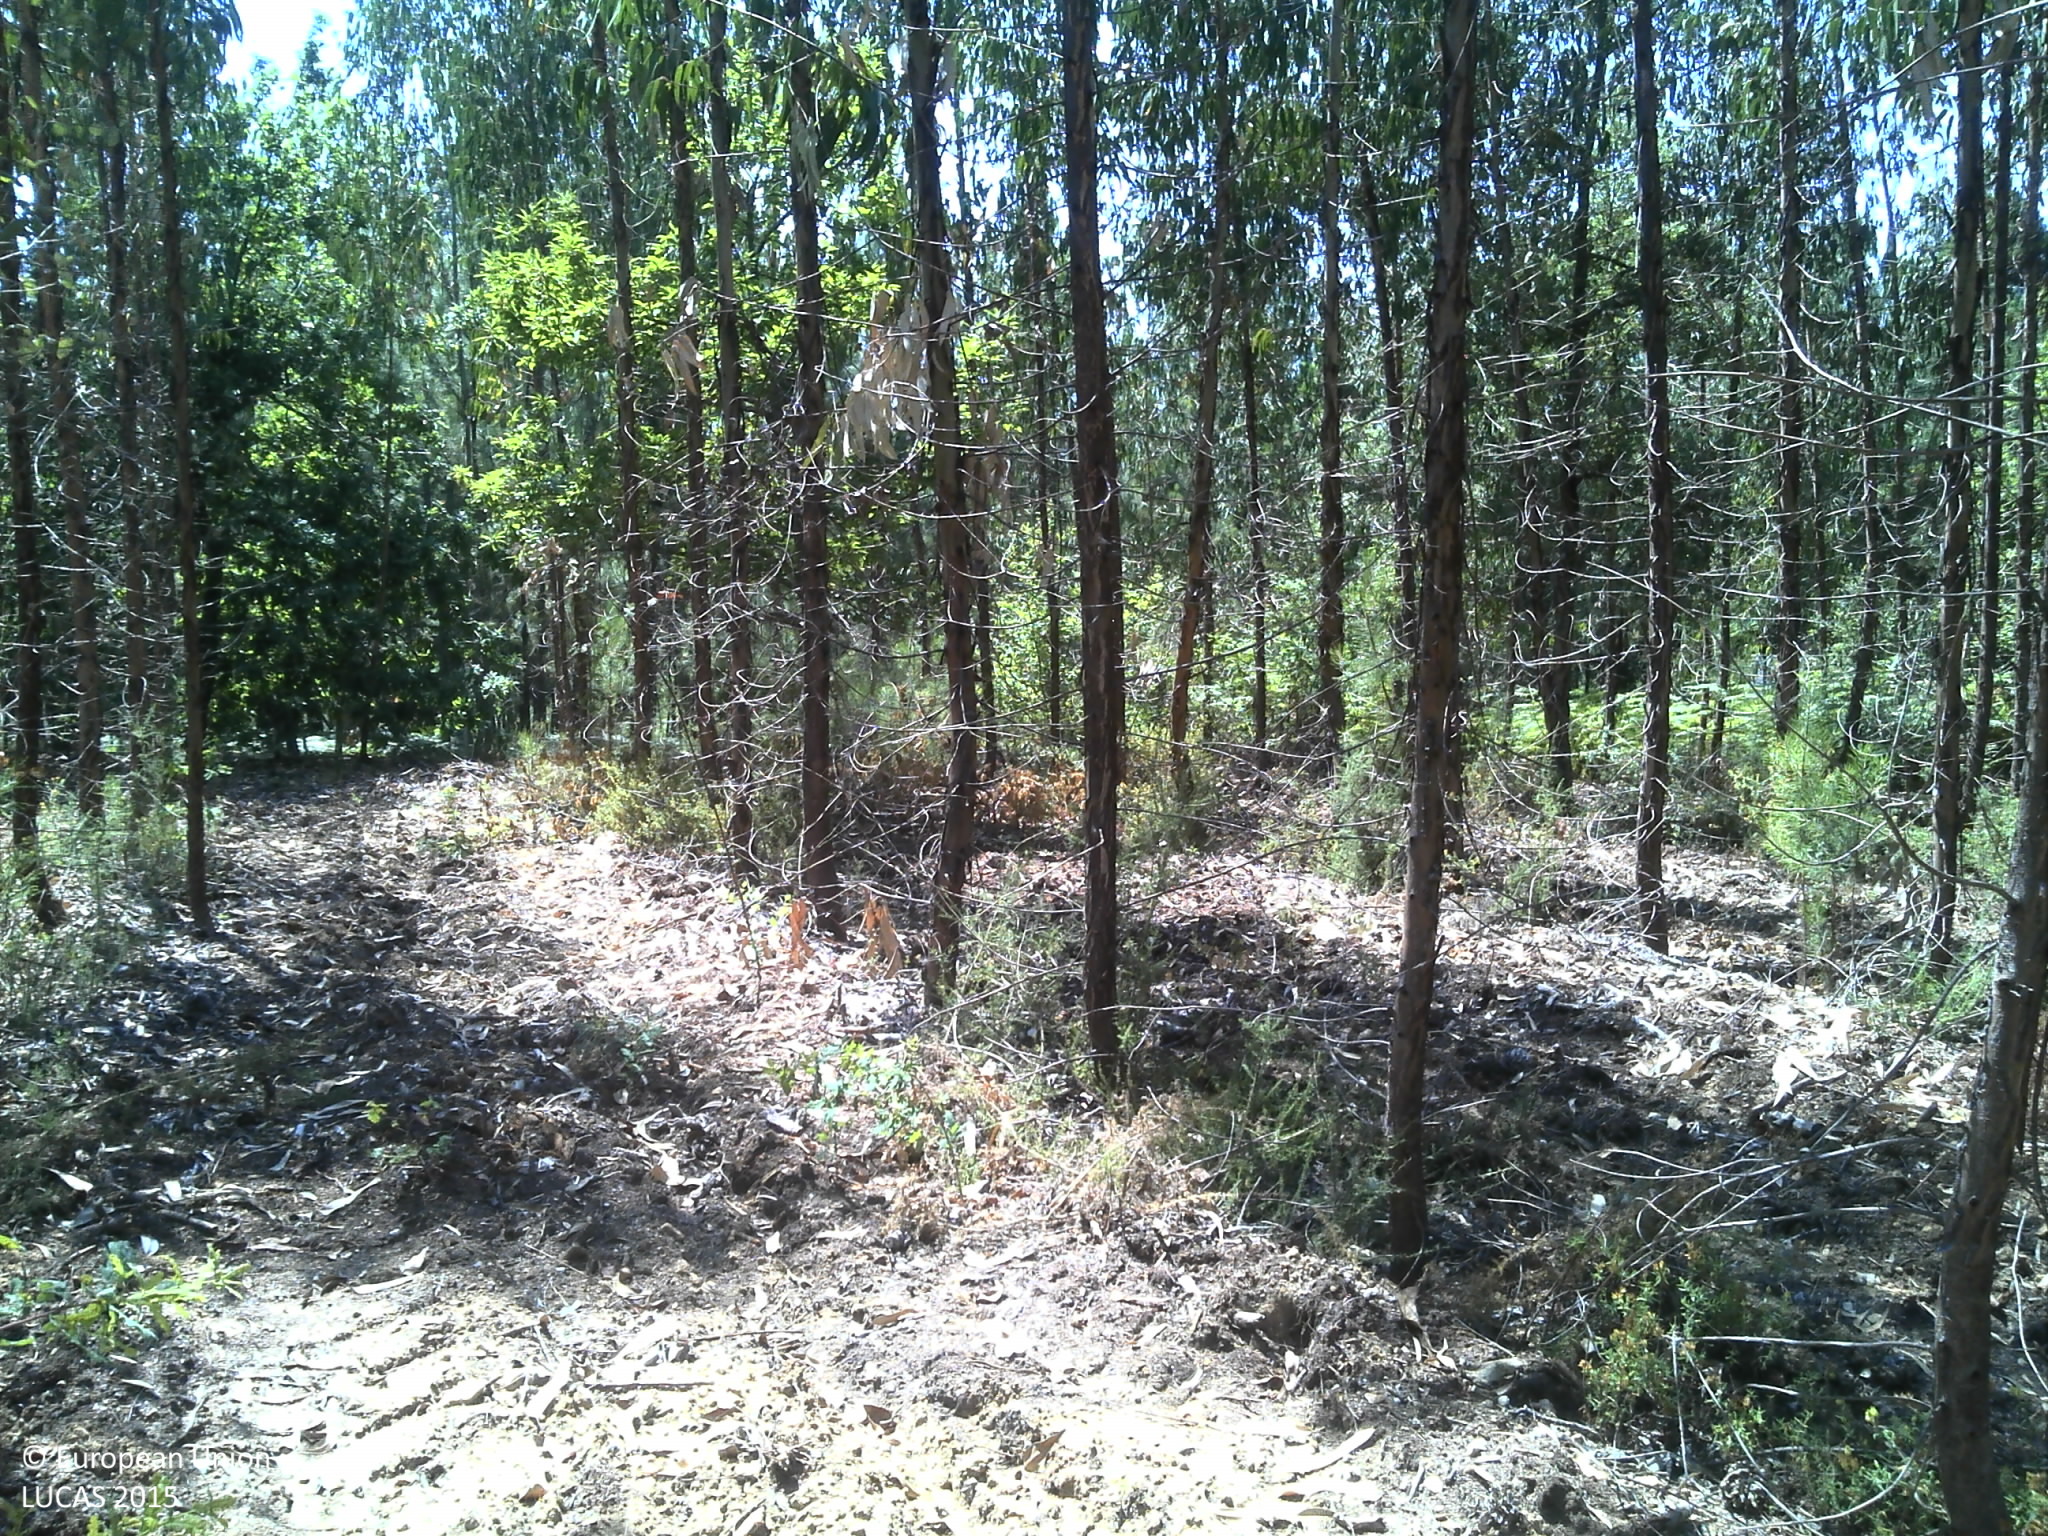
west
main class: Woodland
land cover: Broadleaved woodland
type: exotic forest
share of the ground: 25 - 50 %
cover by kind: broadleaved forest trees 50 %, unconsolidated bare surface 35 %, shrubs 15 %
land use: Forestry
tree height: > 5 m
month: July
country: PT
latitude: 40.3067
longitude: -7.9931
